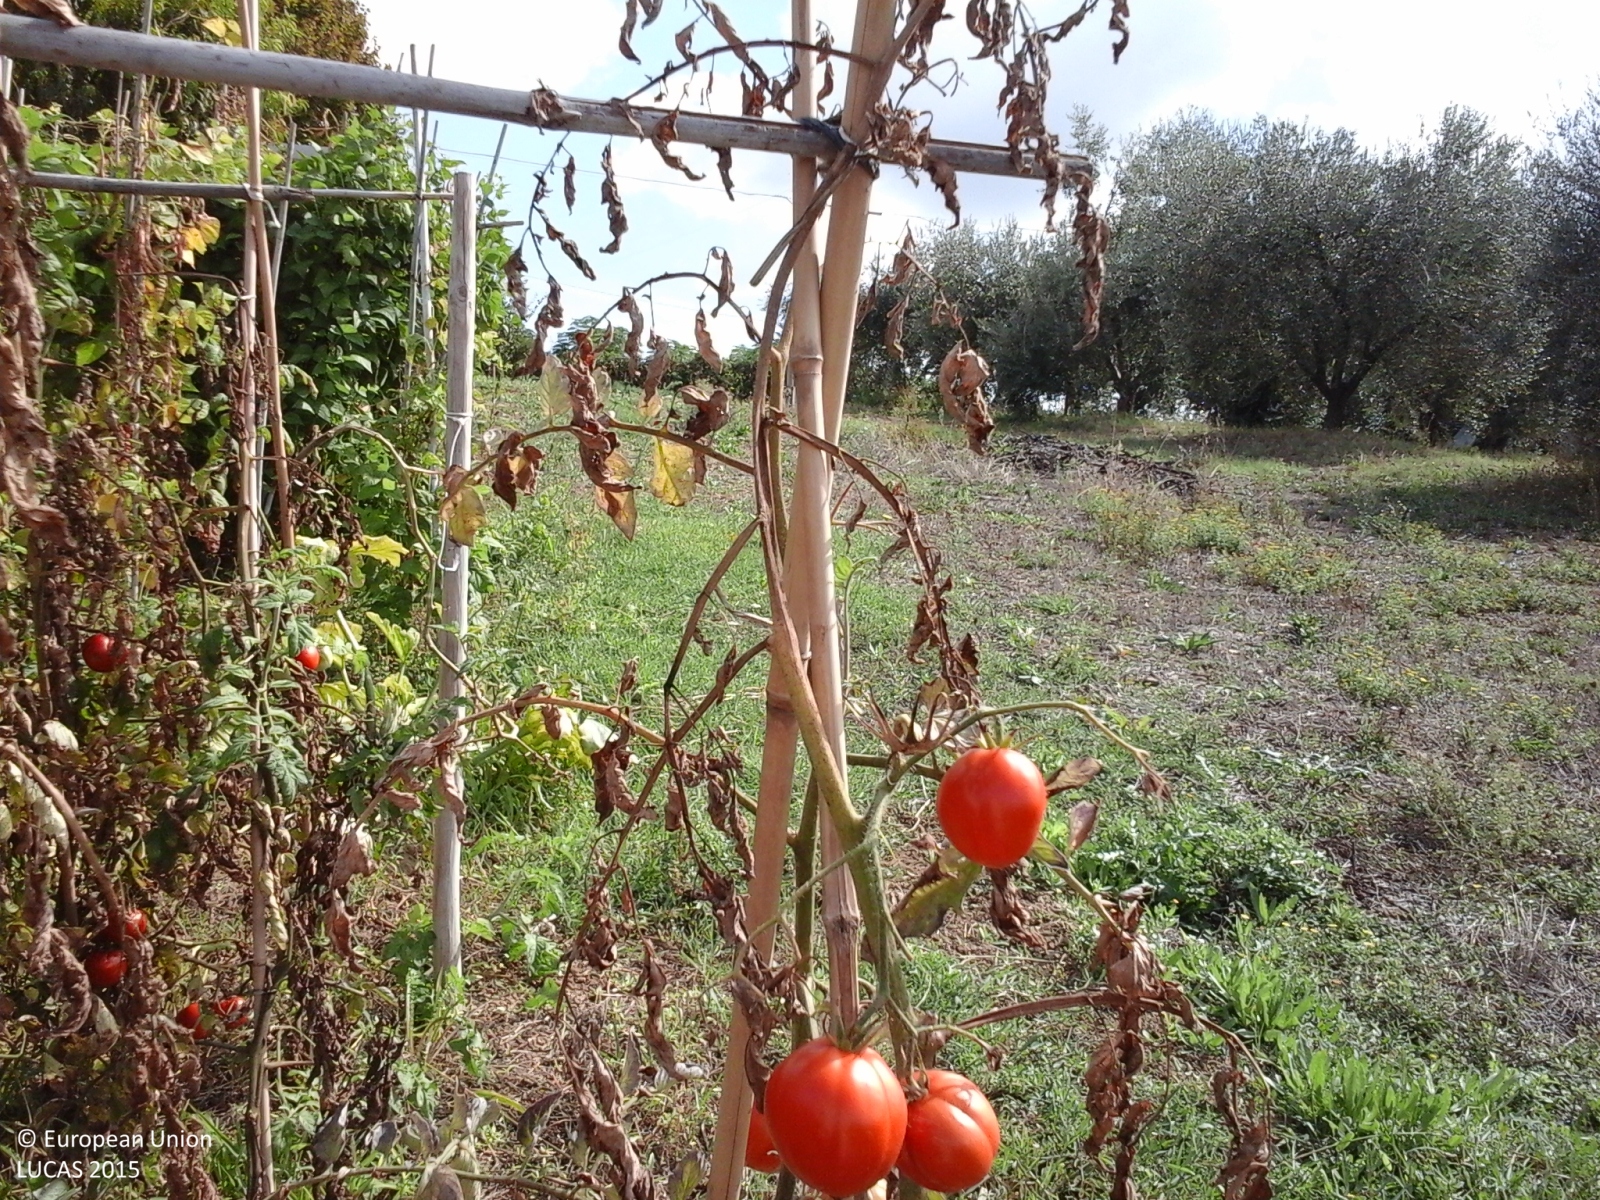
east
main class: Cropland
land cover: Tomatoes
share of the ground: > 75 %
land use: Kitchen garden
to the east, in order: Tomatoes; Dry pulses; Other fresh vegetables; Spontaneously vegetated surfaces; Abandoned hedges; Artificial constructions in urban areas; Olive groves; Spontaneously vegetated surfaces
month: September
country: IT
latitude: 42.8351
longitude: 13.8186
